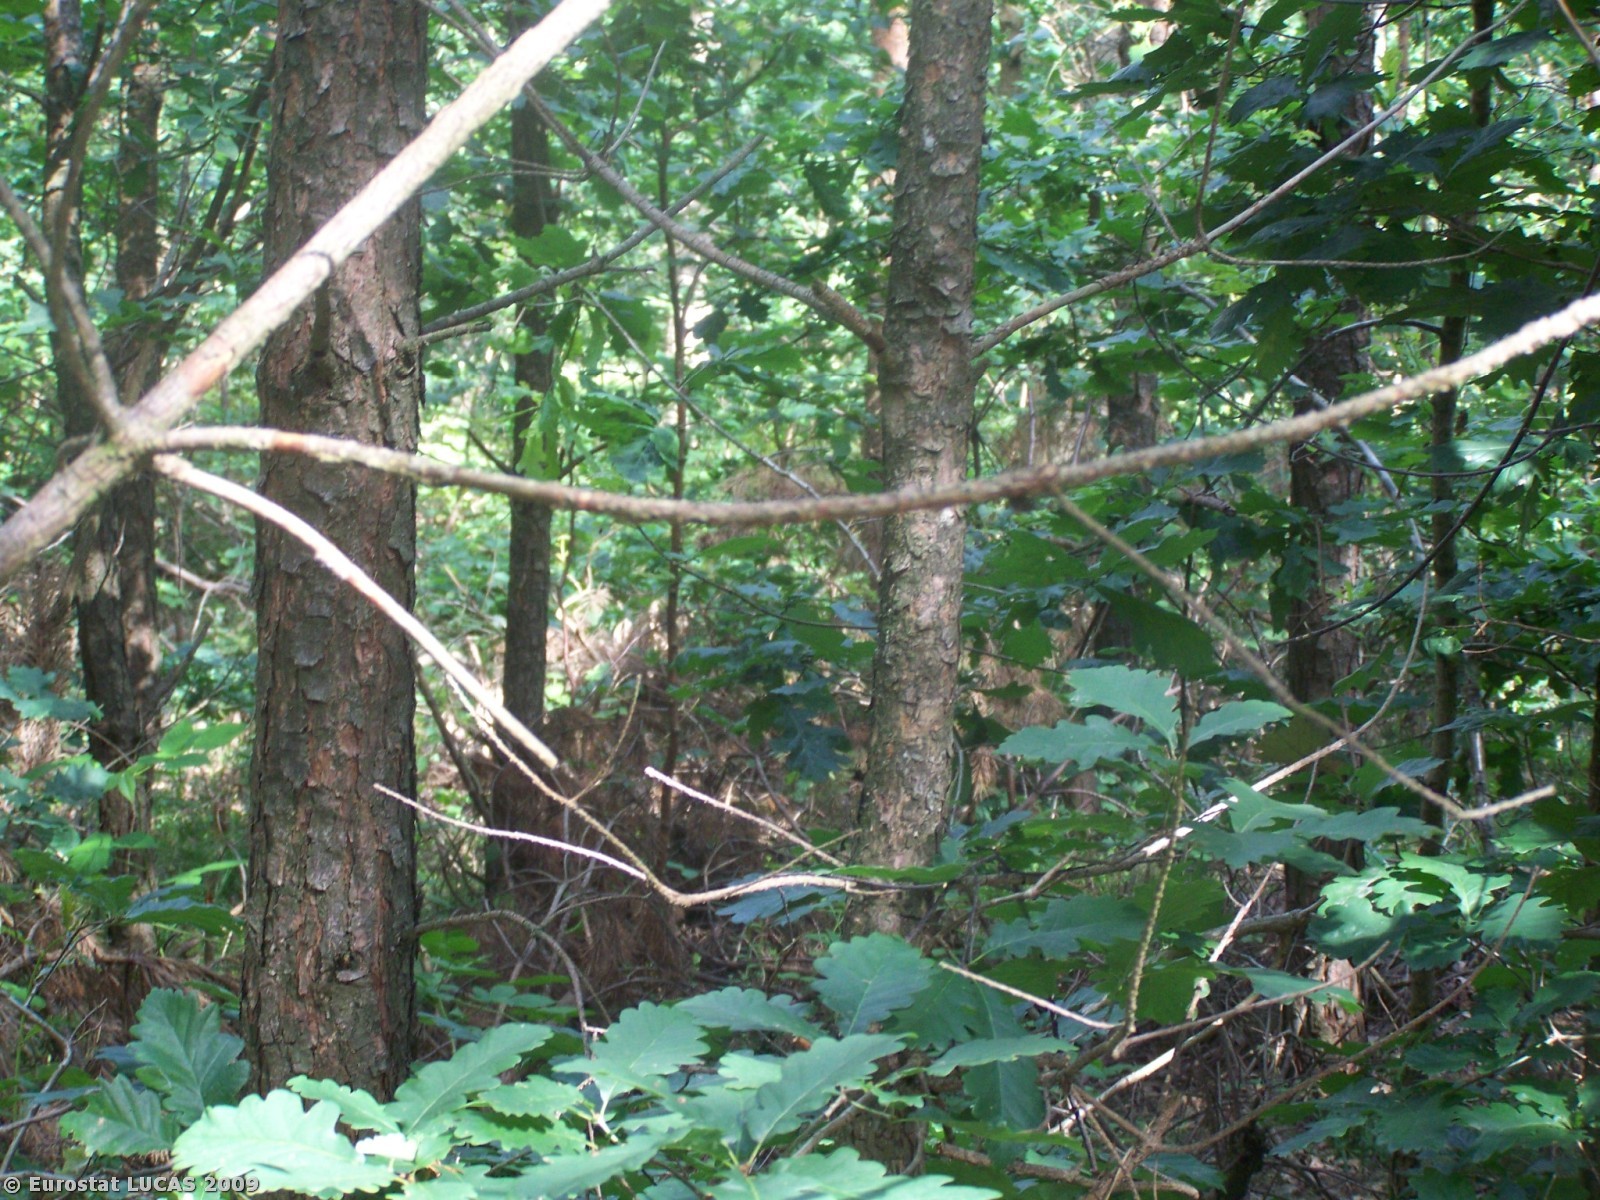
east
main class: Woodland
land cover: Mixed woodland
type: hemiboreal forest and nemoral coniferous forest and mixed broadleaved-coniferous forest
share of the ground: > 75 %
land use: Forestry
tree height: > 5 m
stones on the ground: < 10 %
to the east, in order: Mixed woodland; Broadleaved woodland; Grassland with sparse tree/shrub cover; Electric lines; Grassland with sparse tree/shrub cover; Grass margins; Paved roads, cycling and walking lanes; Grass margins; Ditches and canals; Broadleaved woodland; Ditches and canals; Broadleaved woodland; Coniferous woodland; Broadleaved woodland; Coniferous woodland; Mixed woodland
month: July
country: PL
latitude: 51.5453
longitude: 21.4859
